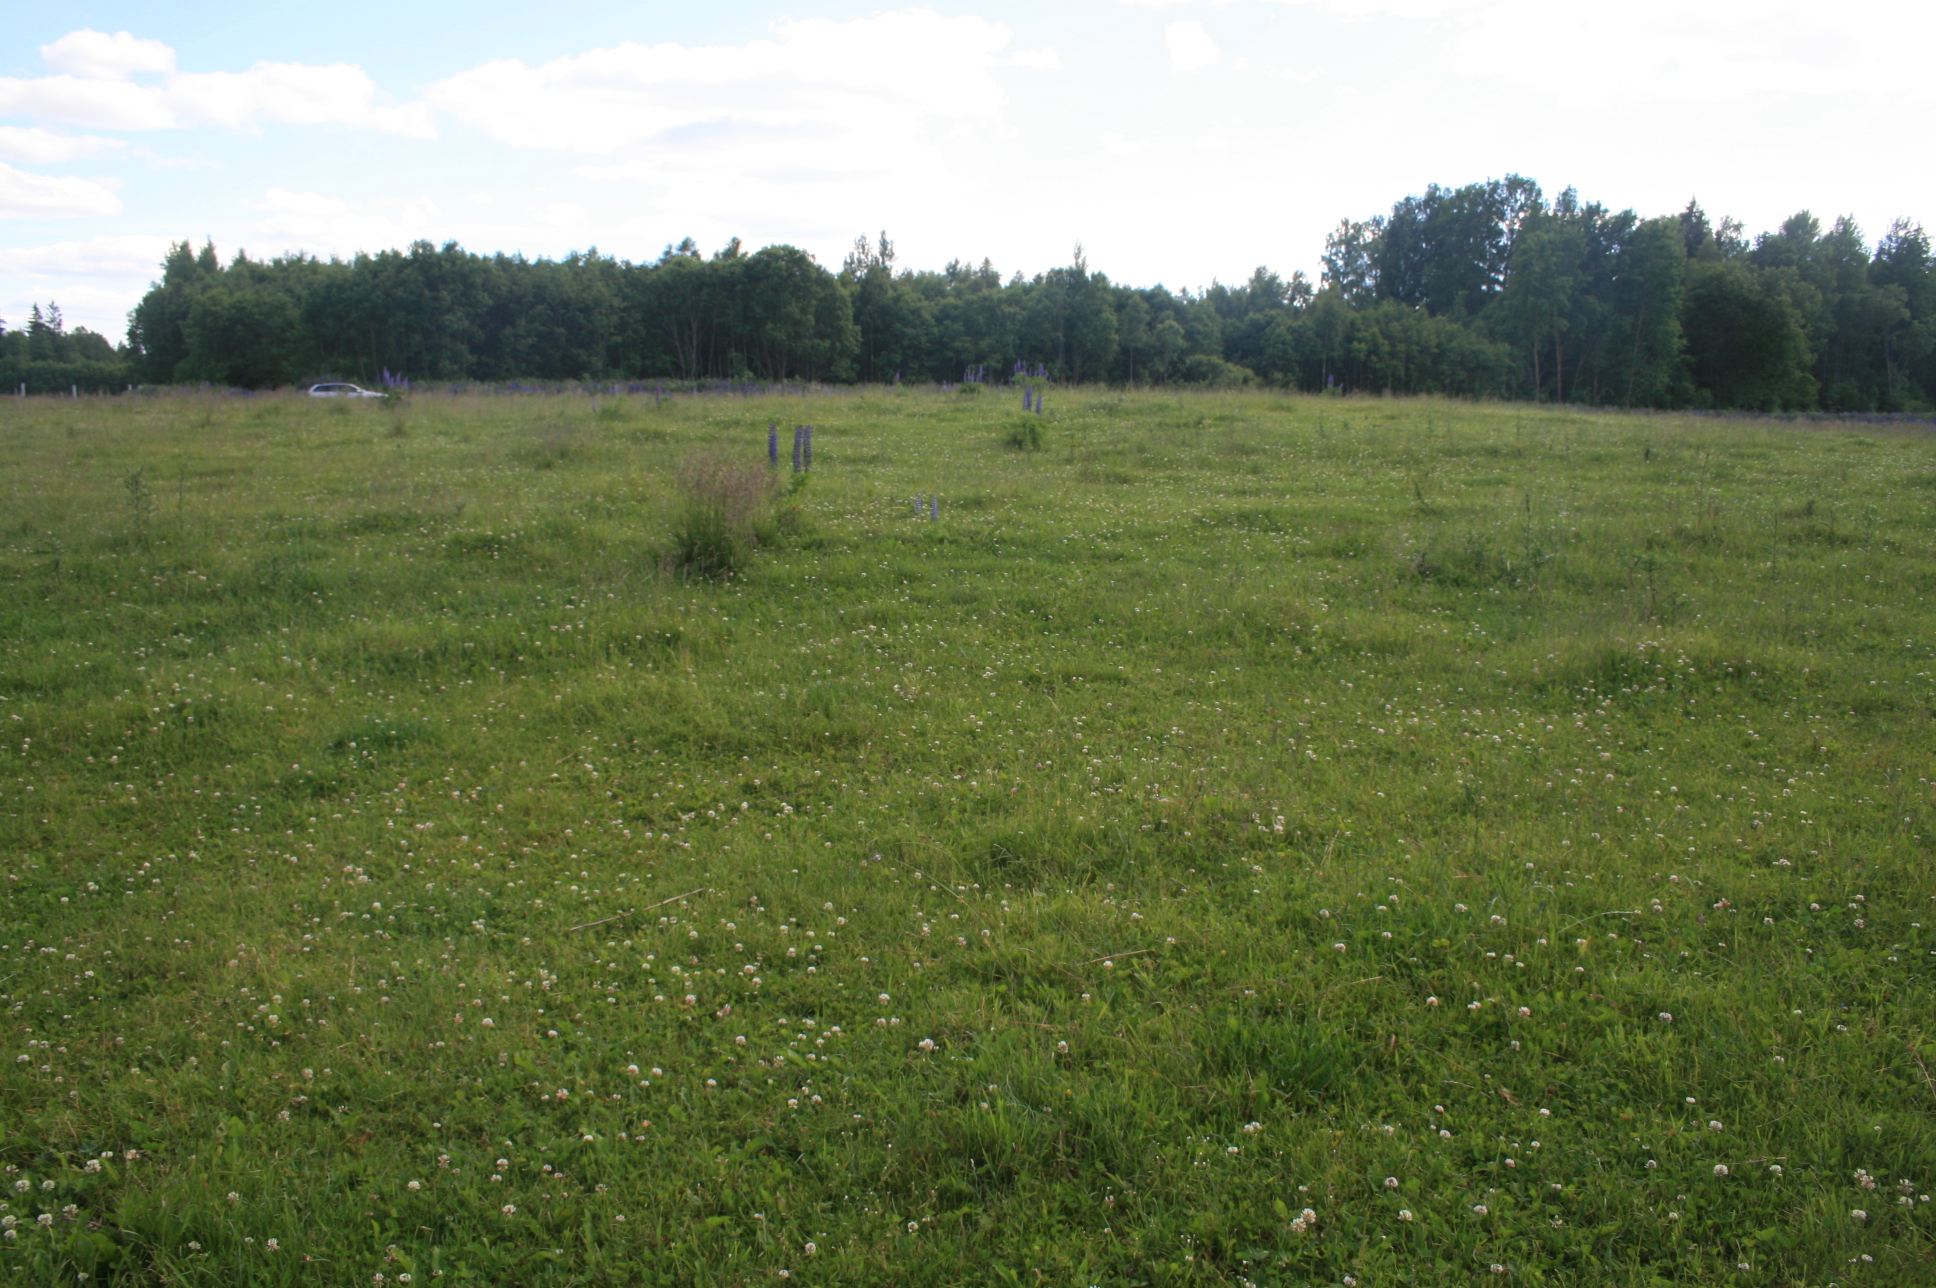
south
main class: Grassland
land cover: Grassland without tree/shrub cover
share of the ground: > 75 %
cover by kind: herbaceous plants 100 %
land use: Agriculture (excluding fallow land and kitchen gardens)
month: June
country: LT
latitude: 55.4234
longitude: 22.1746
